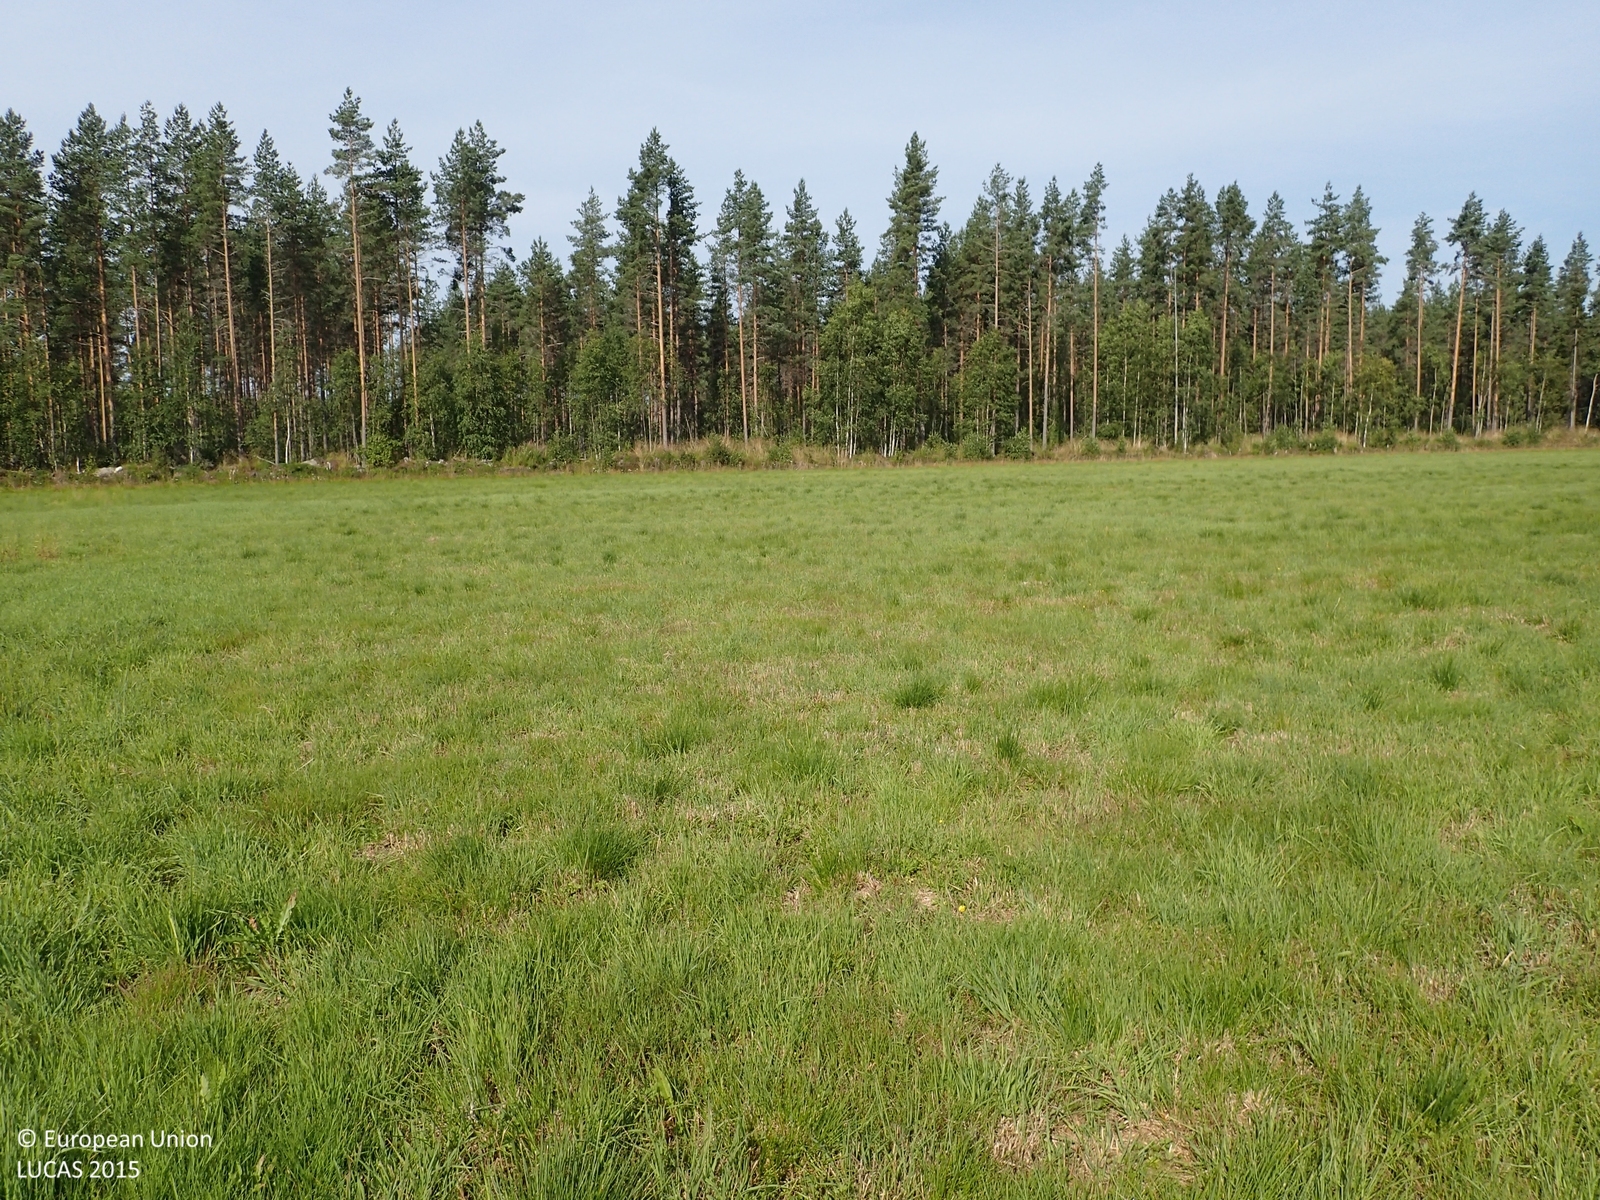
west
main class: Cropland
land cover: Temporary grasslands
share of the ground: > 75 %
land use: Agriculture (excluding fallow land and kitchen gardens)
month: August
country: FI
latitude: 62.5857
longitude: 22.0219
